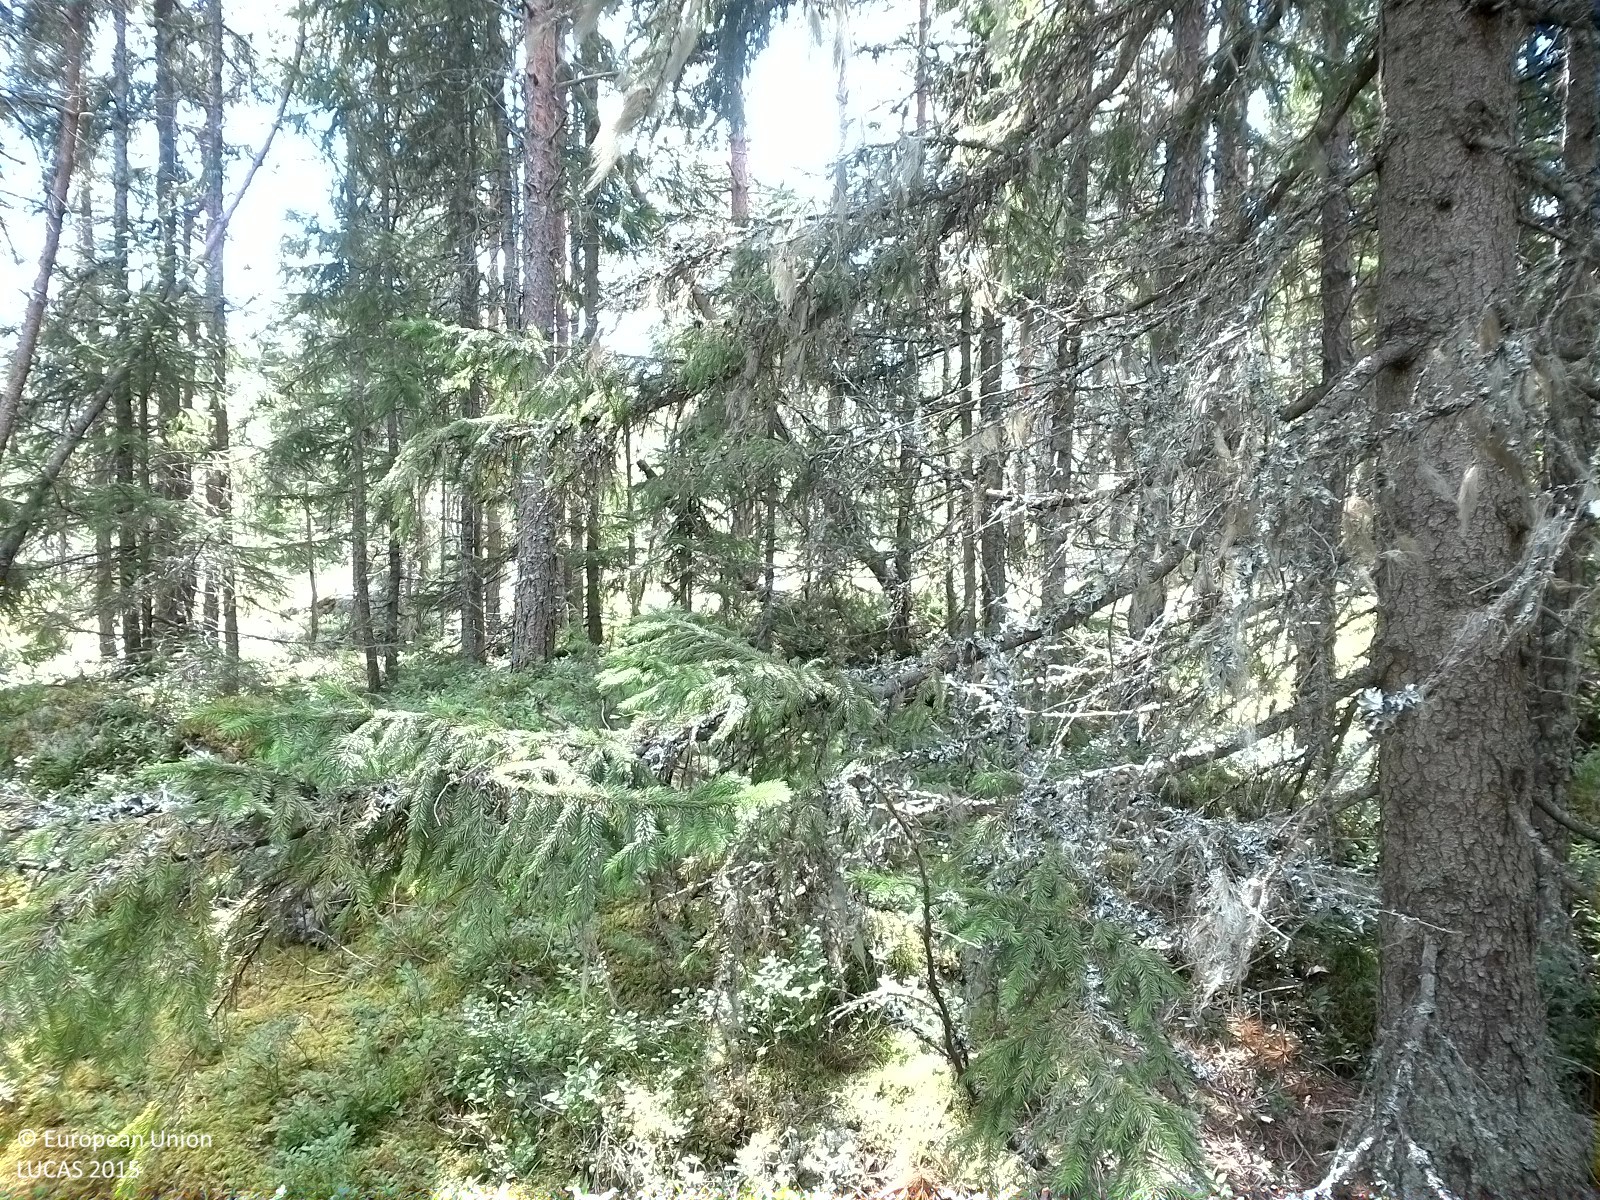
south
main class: Woodland
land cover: Pine dominated coniferous woodland
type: boreal forest
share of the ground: 25 - 50 %
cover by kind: shrubs 50 %, coniferous forest trees 30 %, broadleaved forest trees 10 %, herbaceous plants 10 %
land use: Forestry
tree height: > 5 m
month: August
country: SE
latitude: 58.9049
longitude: 15.3917
